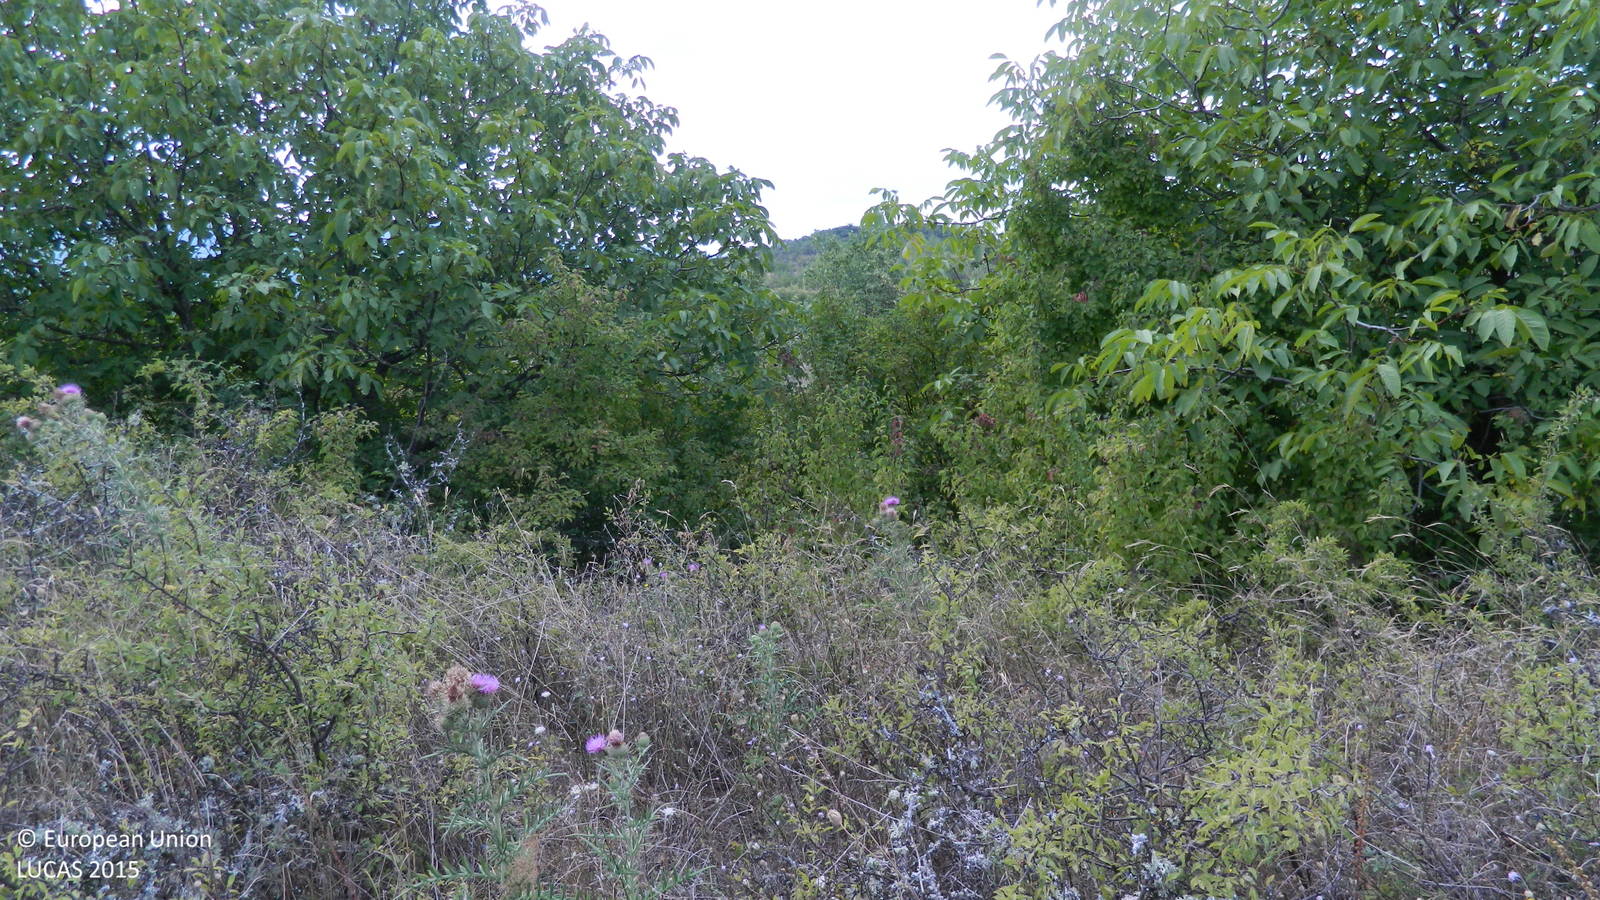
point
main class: Woodland
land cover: Broadleaved woodland
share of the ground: > 75 %
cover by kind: broadleaved forest trees 80 %, shrubs 10 %, herbaceous plants 10 %
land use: Semi-natural and natural areas not in use
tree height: > 5 m
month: August
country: BG
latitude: 41.7019
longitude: 25.8945
